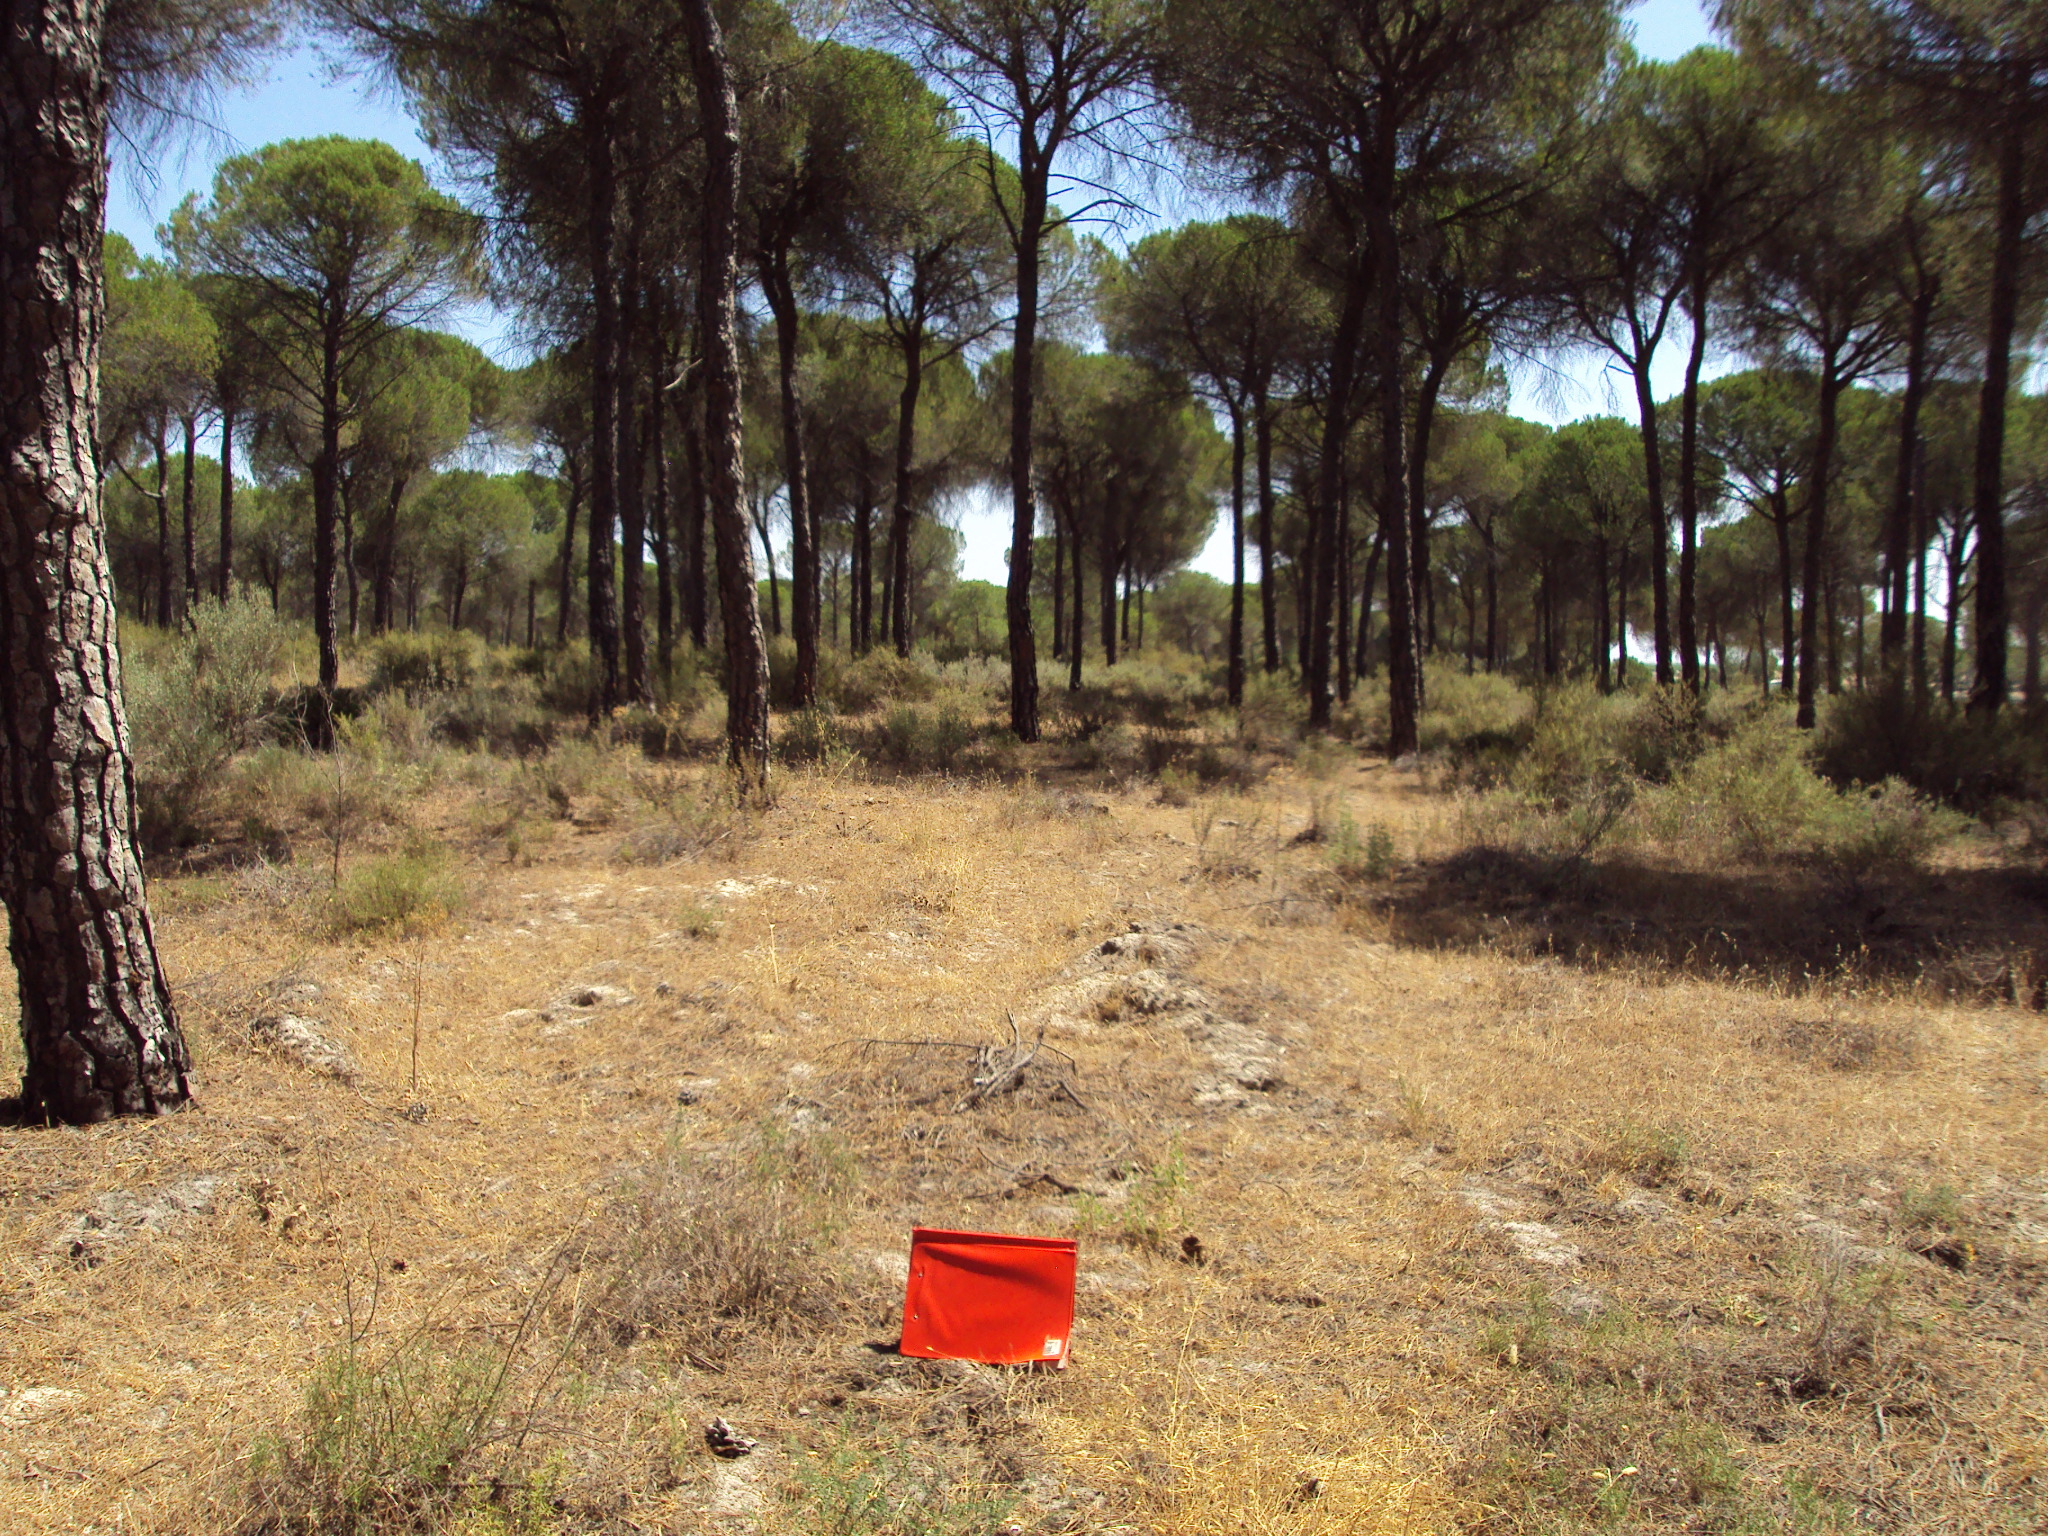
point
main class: Woodland
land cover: Pine dominated coniferous woodland
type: coniferous forest of the mediterranean region
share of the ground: 50 - 75 %
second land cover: Spontaneously vegetated surfaces
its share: > 75 %
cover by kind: coniferous forest trees 60 %, shrubs 30 %, herbaceous plants 10 %
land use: Forestry
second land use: Agriculture (excluding fallow land and kitchen gardens)
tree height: > 5 m
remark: Clear cut
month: July
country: ES
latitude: 37.2255
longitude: -6.5640
